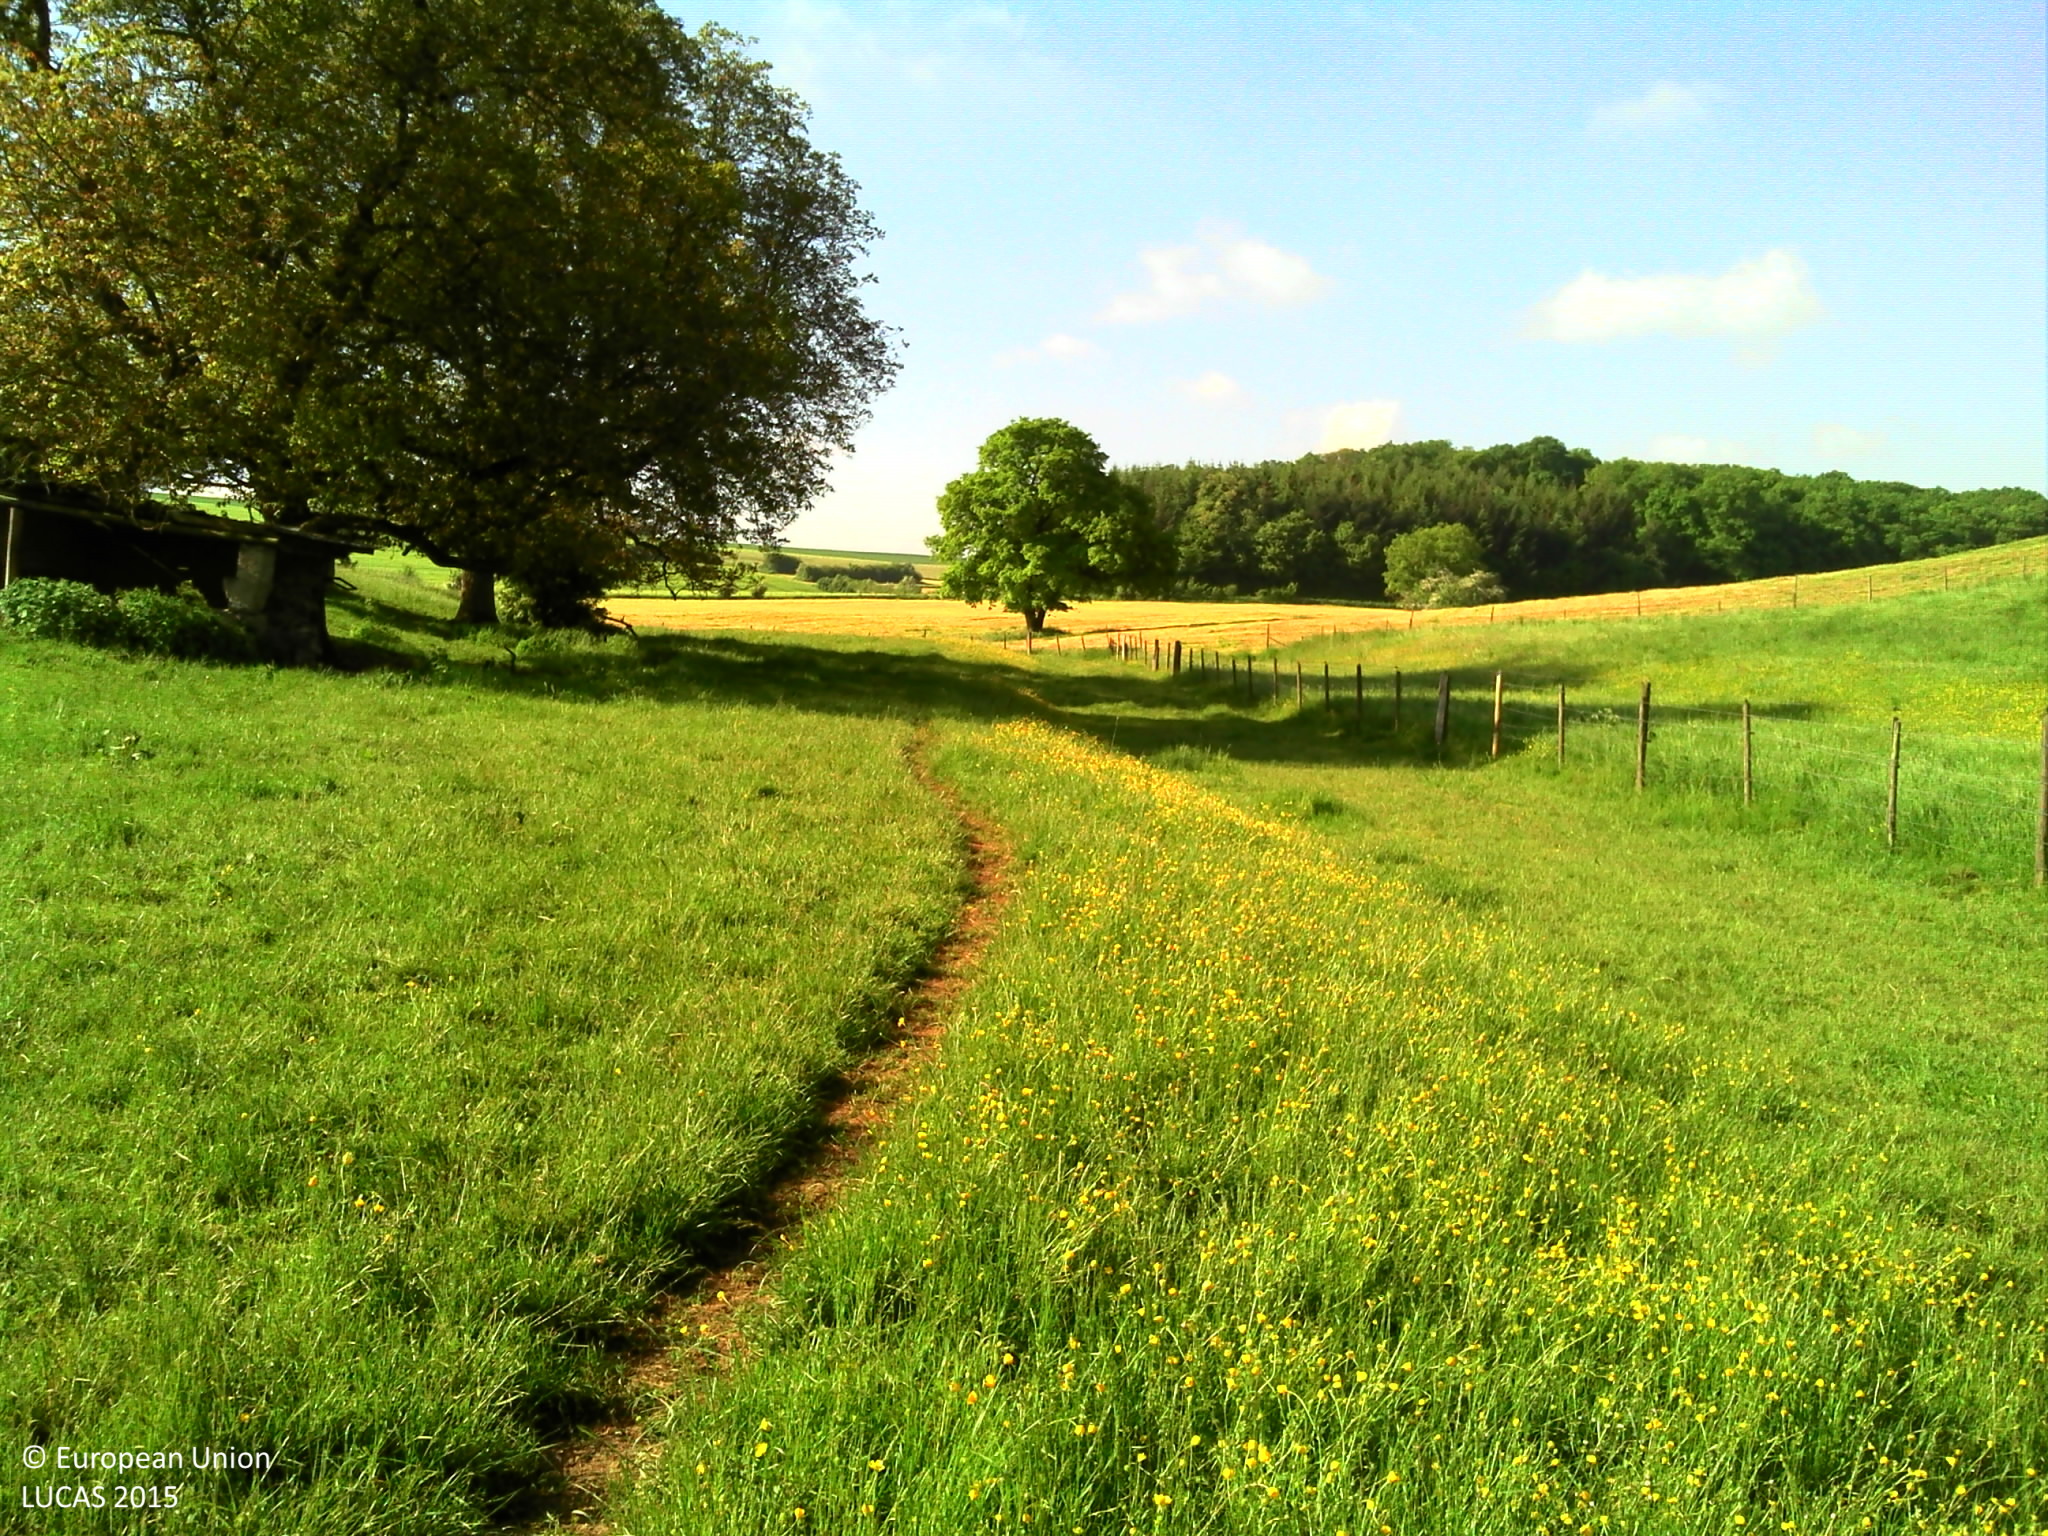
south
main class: Grassland
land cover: Grassland with sparse tree/shrub cover
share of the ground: > 75 %
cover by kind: herbaceous plants 95 %, broadleaved forest trees 5 %
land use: Agriculture (excluding fallow land and kitchen gardens)
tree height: < 5 m
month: May
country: LU
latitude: 49.6598
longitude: 6.4117
